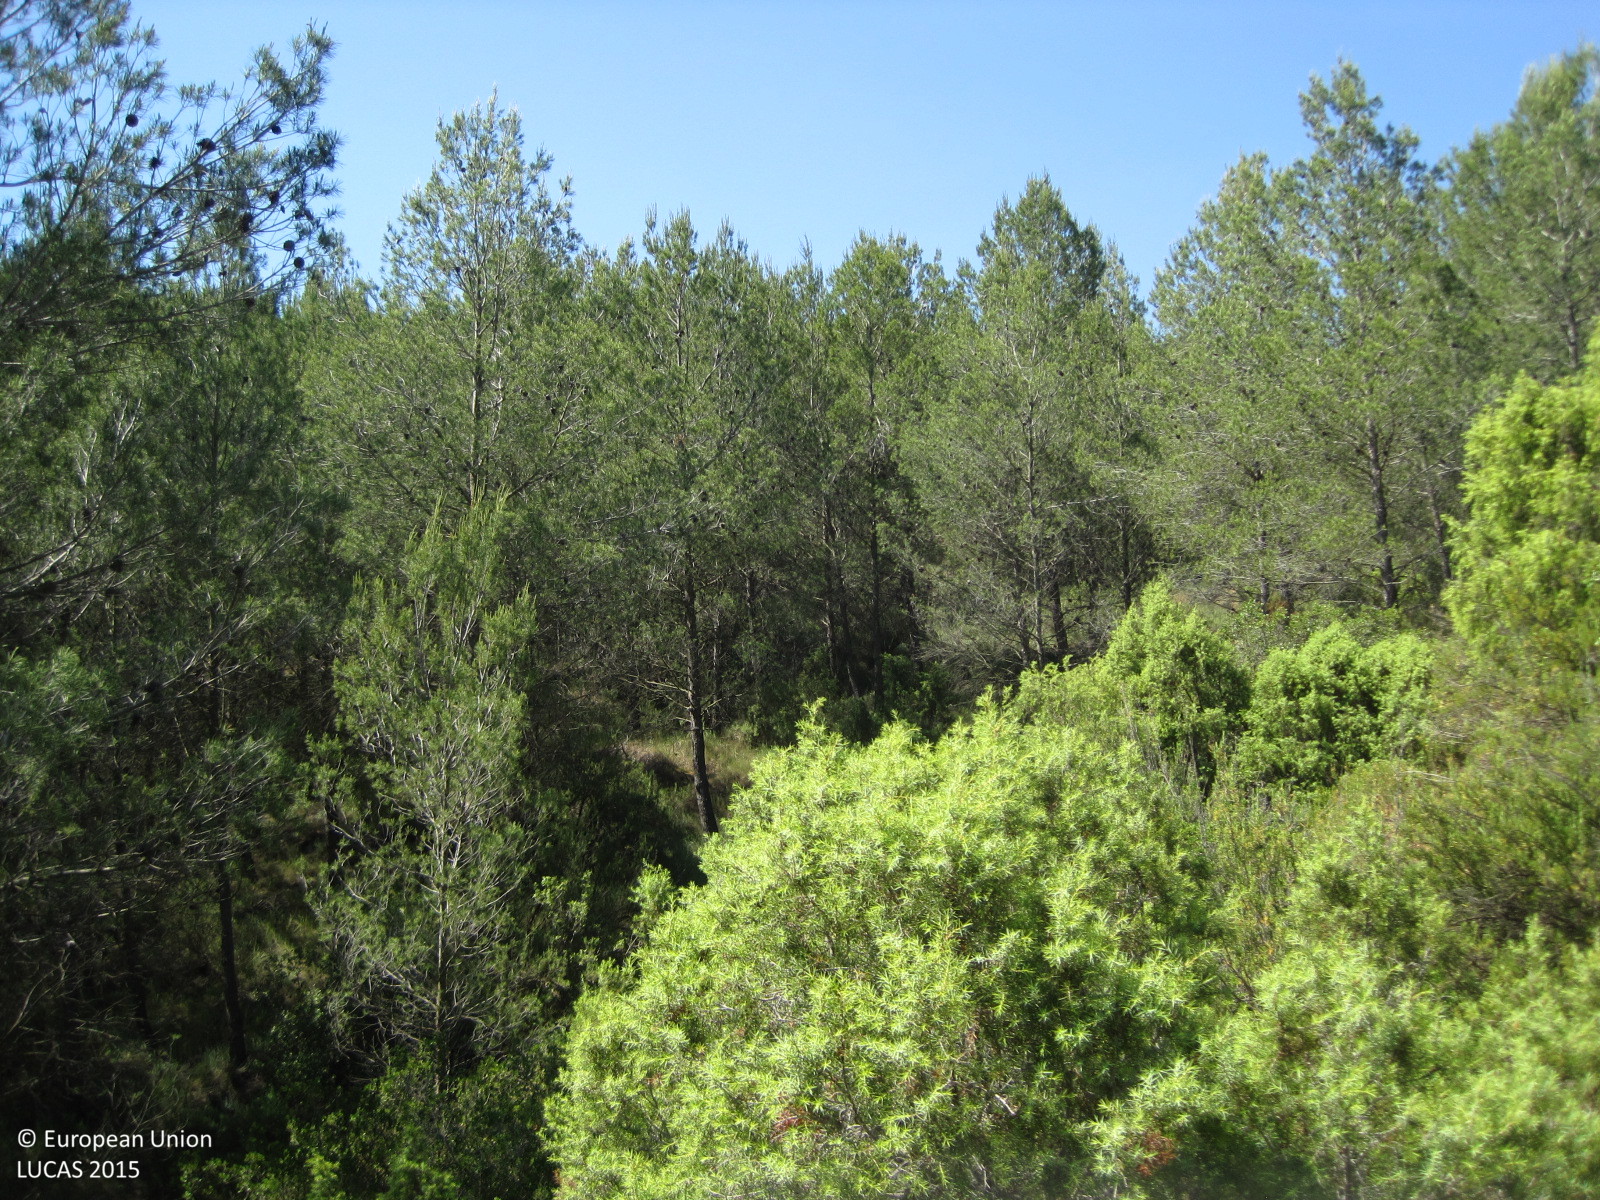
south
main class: Woodland
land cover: Pine dominated coniferous woodland
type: coniferous forest of the mediterranean region
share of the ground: 10 - 25 %
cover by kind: shrubs 50 %, unconsolidated bare surface 20 %, coniferous forest trees 15 %, herbaceous plants 15 %
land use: Forestry
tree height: > 5 m
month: June
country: ES
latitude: 39.7394
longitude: -1.1483
